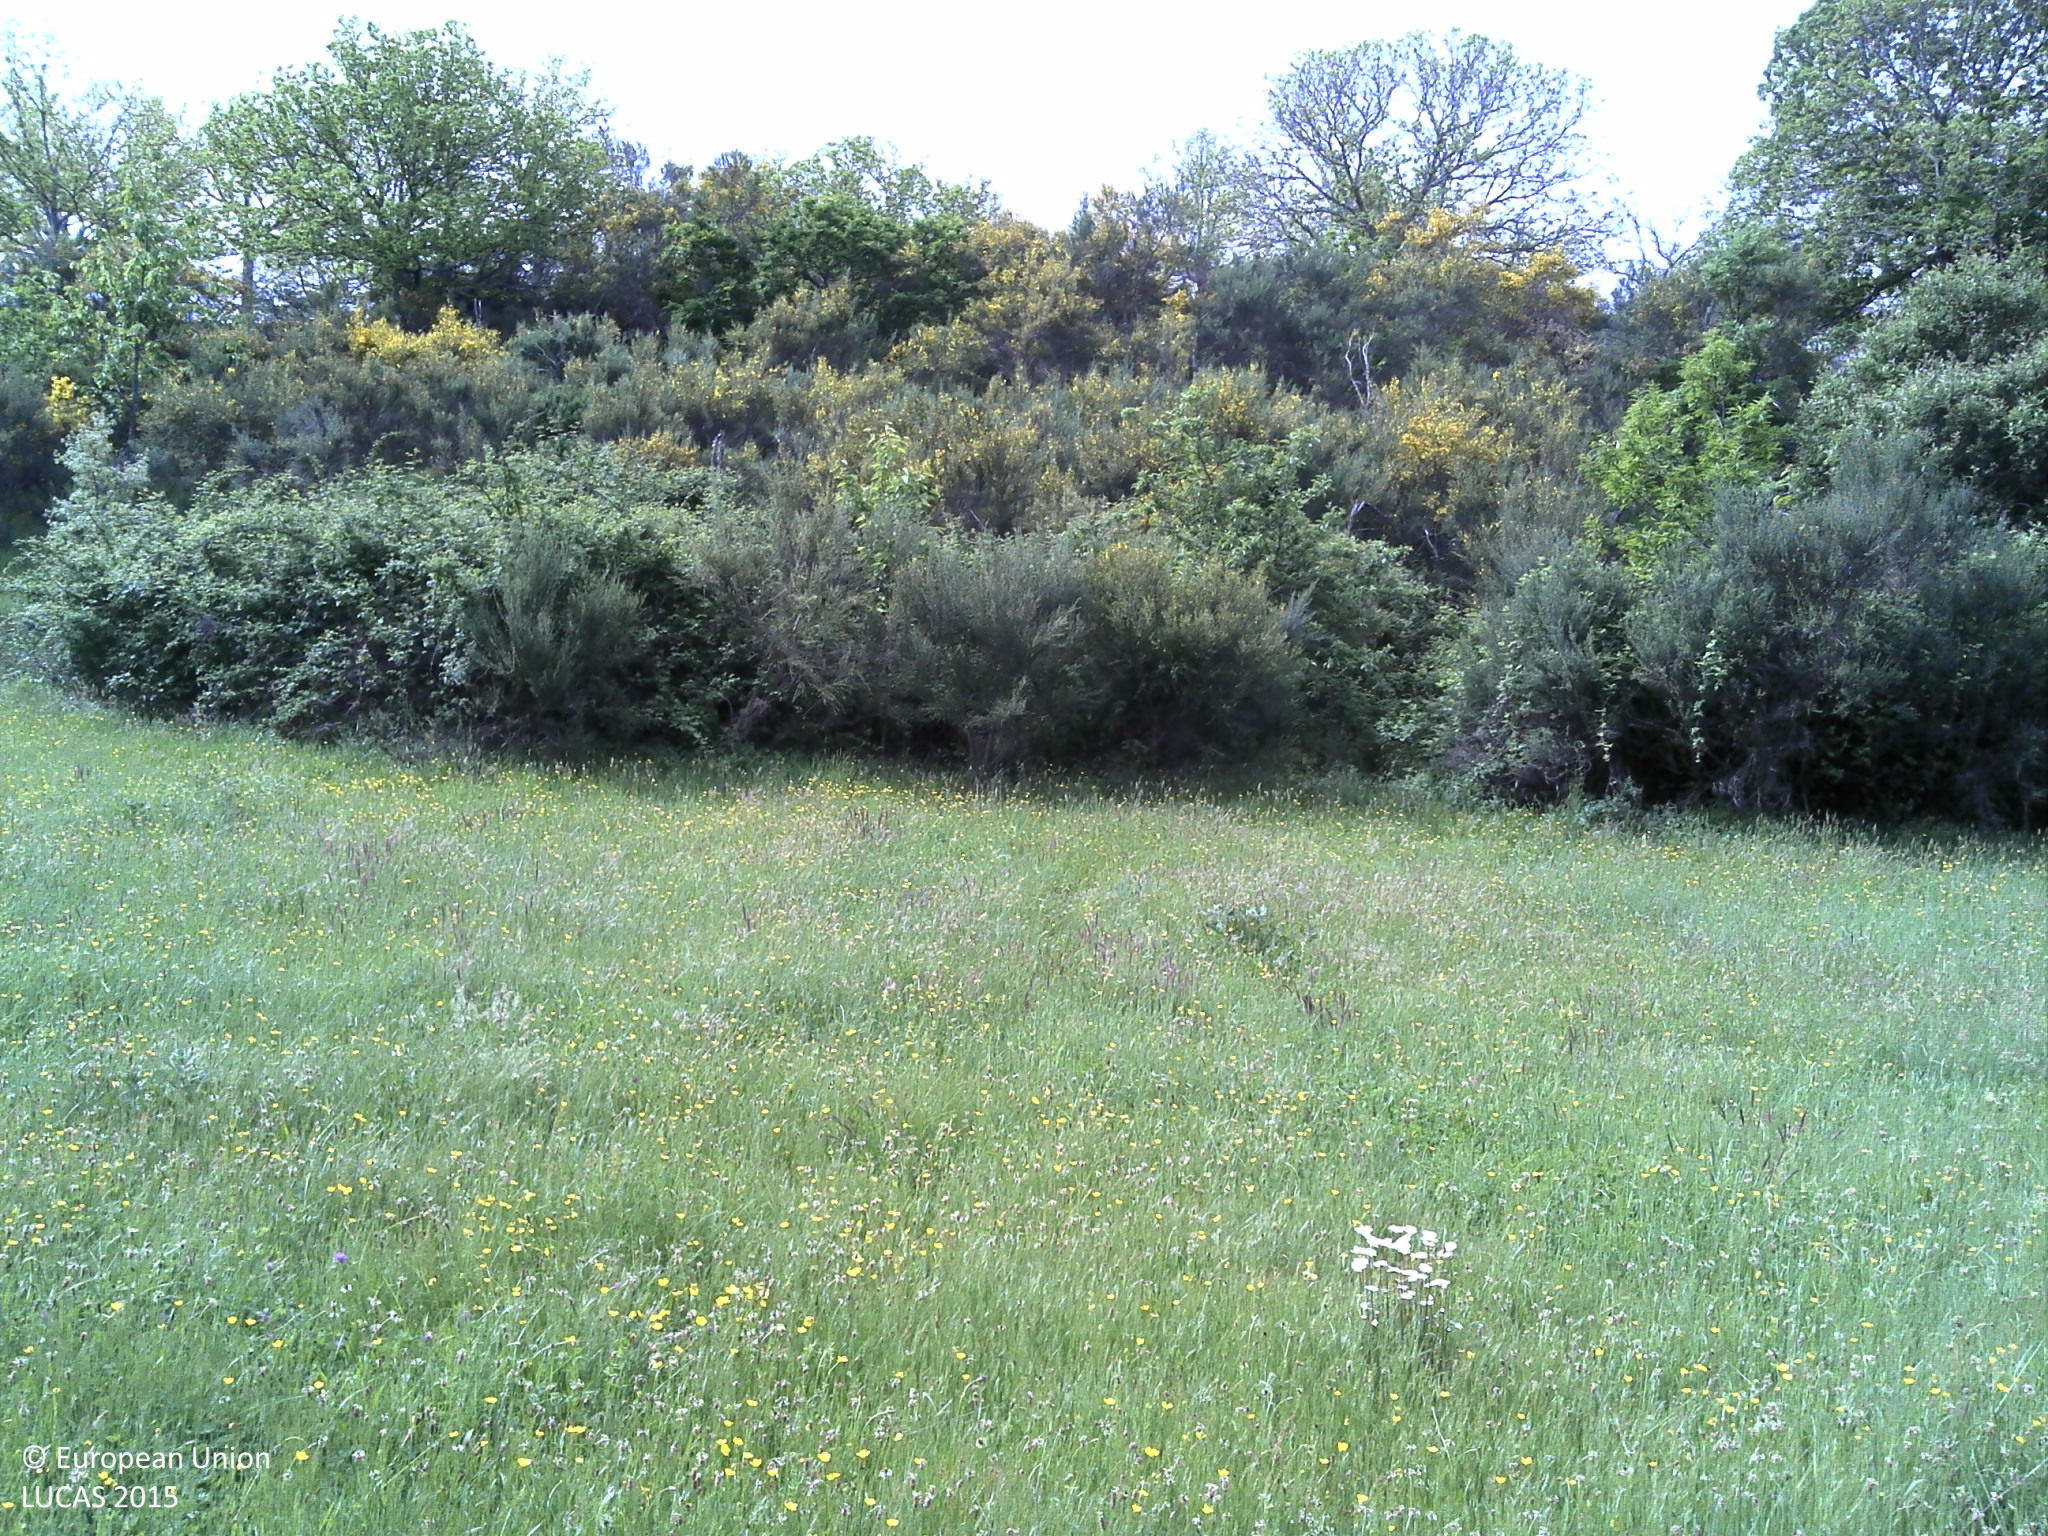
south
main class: Grassland
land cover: Grassland without tree/shrub cover
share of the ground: > 75 %
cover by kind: herbaceous plants 90 %, unconsolidated bare surface 10 %
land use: Agriculture (excluding fallow land and kitchen gardens)
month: May
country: PT
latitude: 41.8338
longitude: -7.0882
